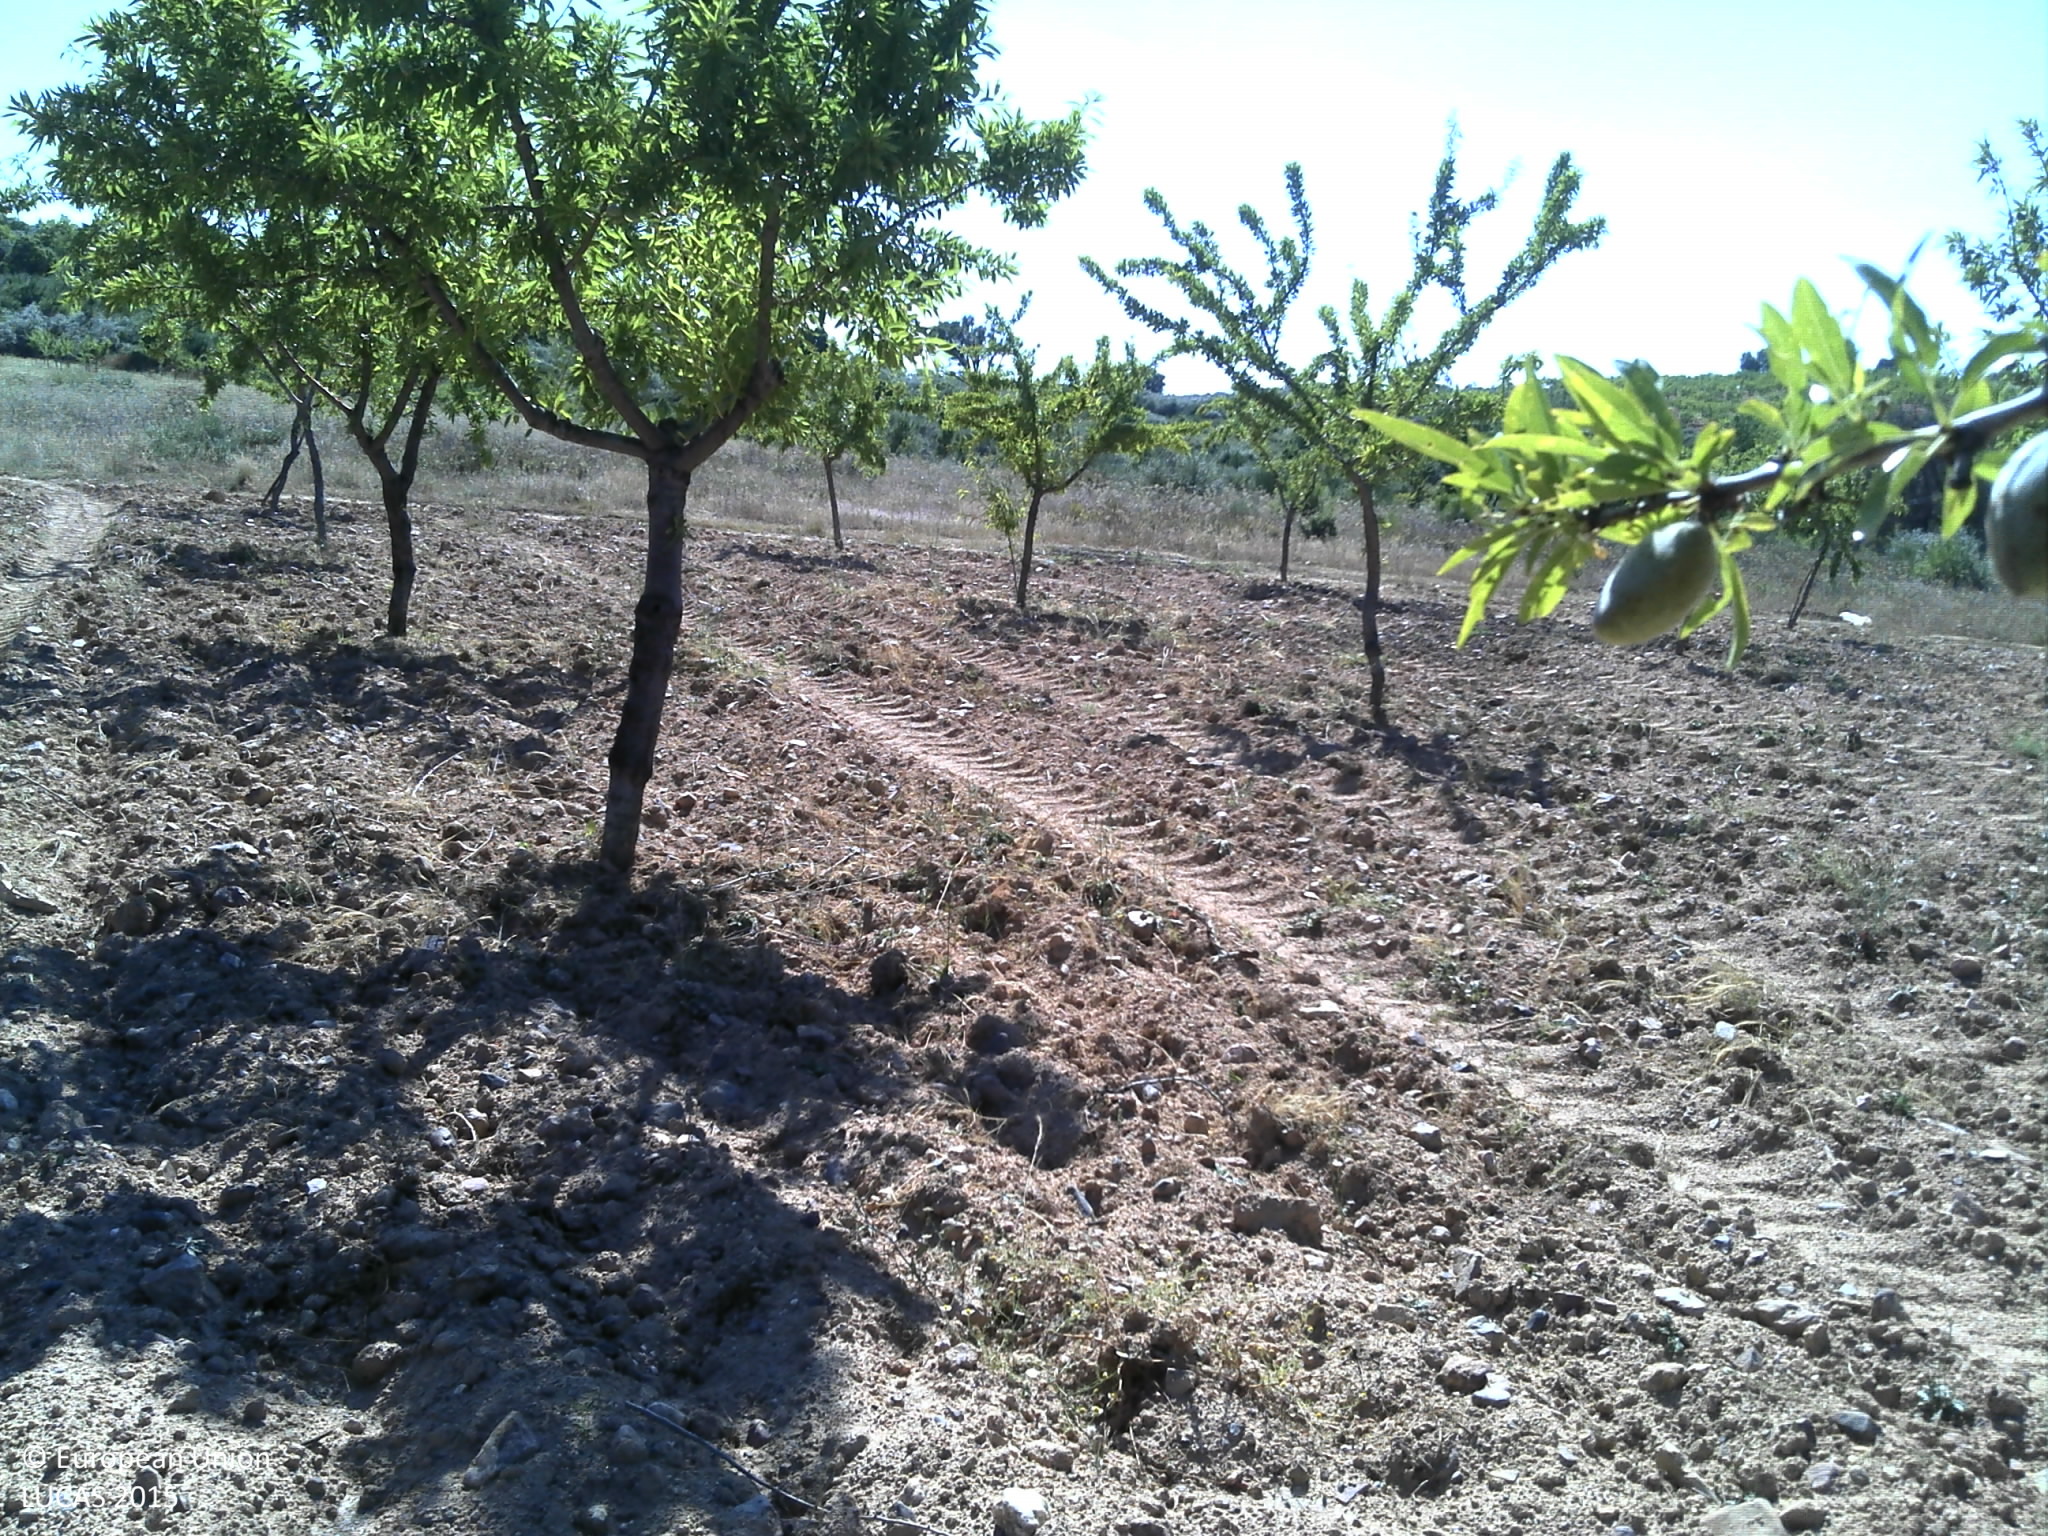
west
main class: Cropland
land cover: Nuts trees
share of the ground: < 10 %
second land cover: Other bare soil
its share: > 75 %
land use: Agriculture (excluding fallow land and kitchen gardens)
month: June
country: PT
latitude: 41.1921
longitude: -6.8585
